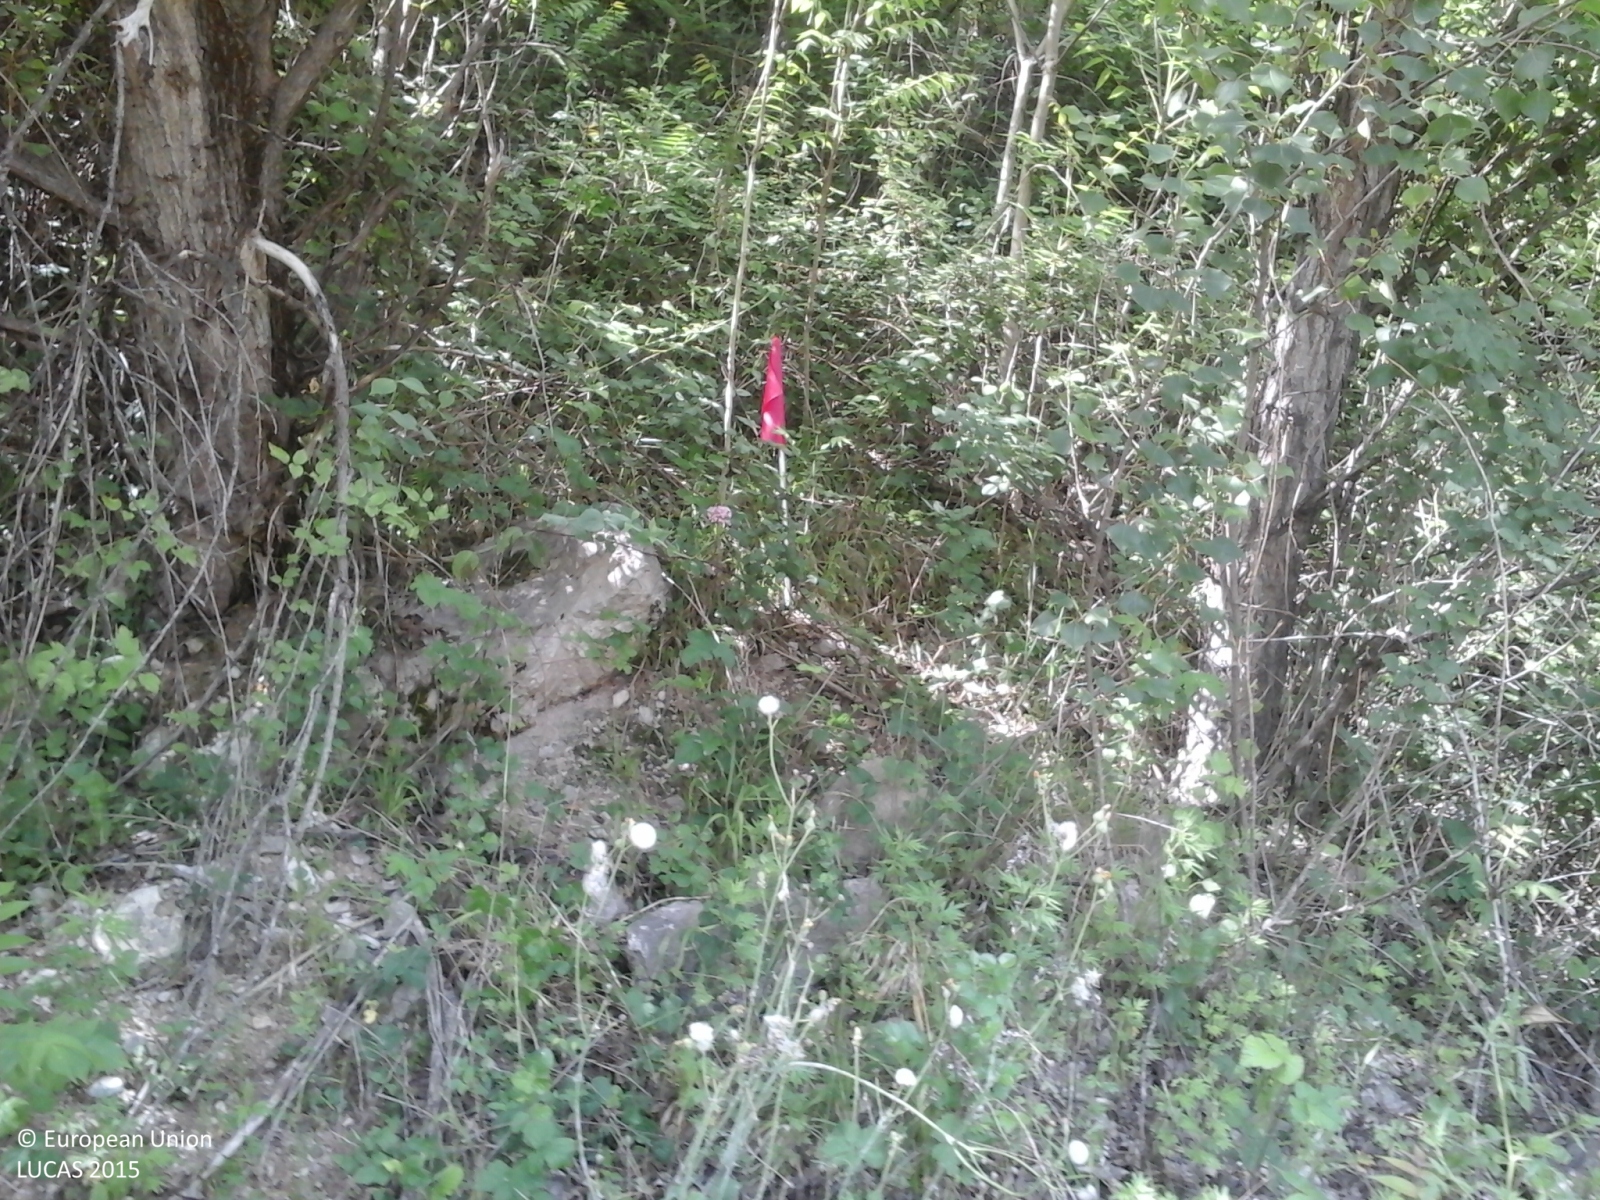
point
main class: Woodland
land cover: Broadleaved woodland
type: non-riverine alder, birch or aspen forest
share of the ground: > 75 %
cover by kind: broadleaved forest trees 95 %, shrubs 5 %
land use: Semi-natural and natural areas not in use
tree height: > 5 m
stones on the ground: > 50 %
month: May
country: IT
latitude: 46.2546
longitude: 11.1789
